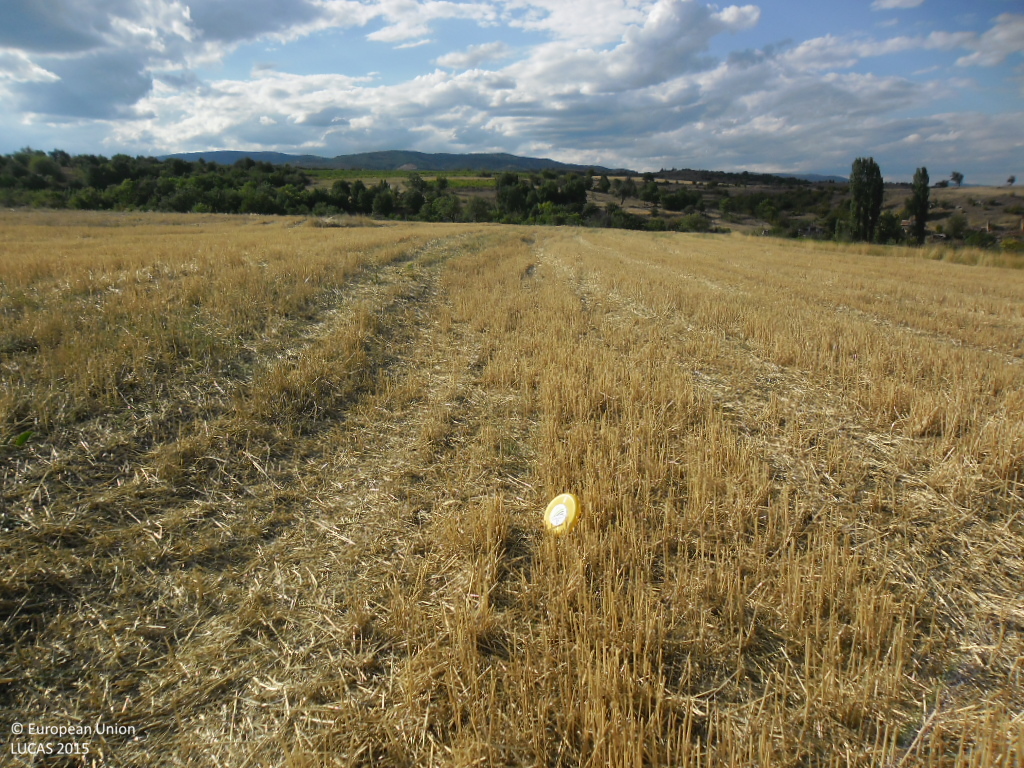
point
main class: Cropland
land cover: Common wheat
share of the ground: 50 - 75 %
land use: Agriculture (excluding fallow land and kitchen gardens)
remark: Harvested field
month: August
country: BG
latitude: 42.0274
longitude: 23.0315
